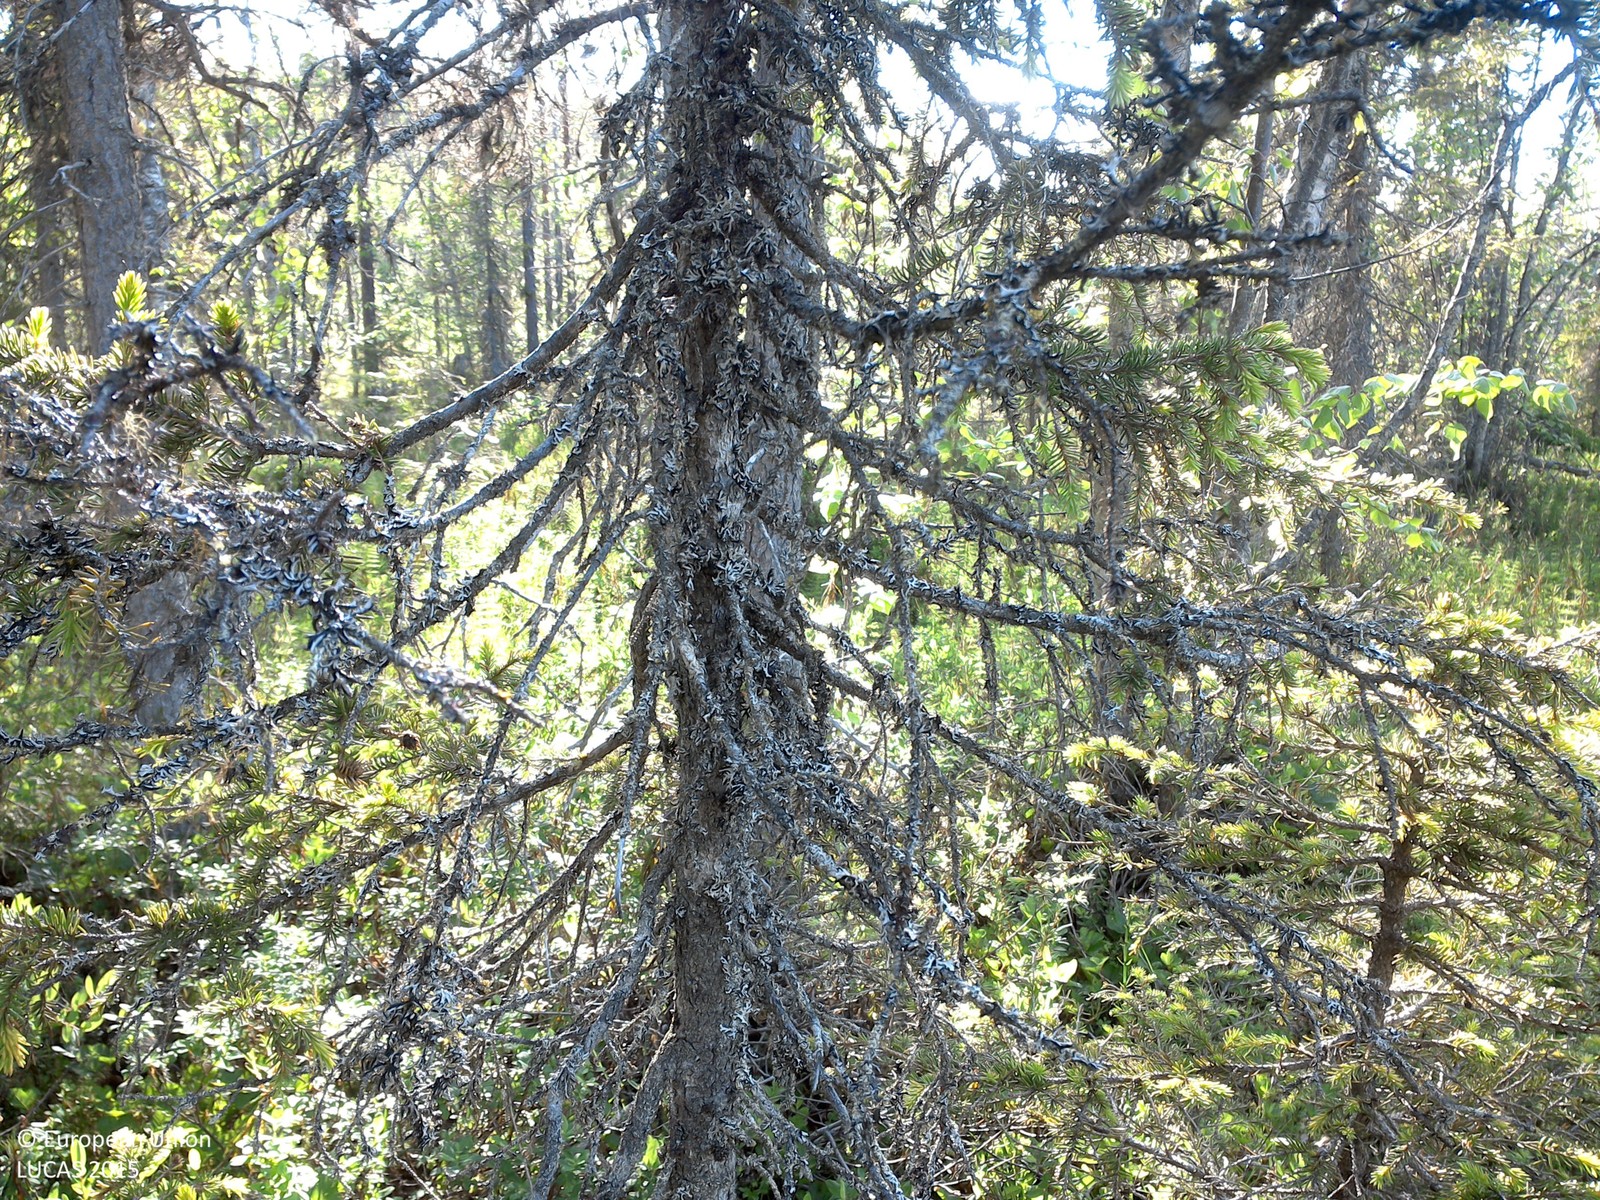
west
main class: Woodland
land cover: Spruce dominated mixed woodland
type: boreal forest
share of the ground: 10 - 25 %
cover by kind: herbaceous plants 35 %, shrubs 30 %, coniferous forest trees 15 %, lichens and mosses 15 %, broadleaved forest trees 5 %
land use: Forestry
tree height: > 5 m
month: July
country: SE
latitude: 66.7211
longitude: 23.5641
